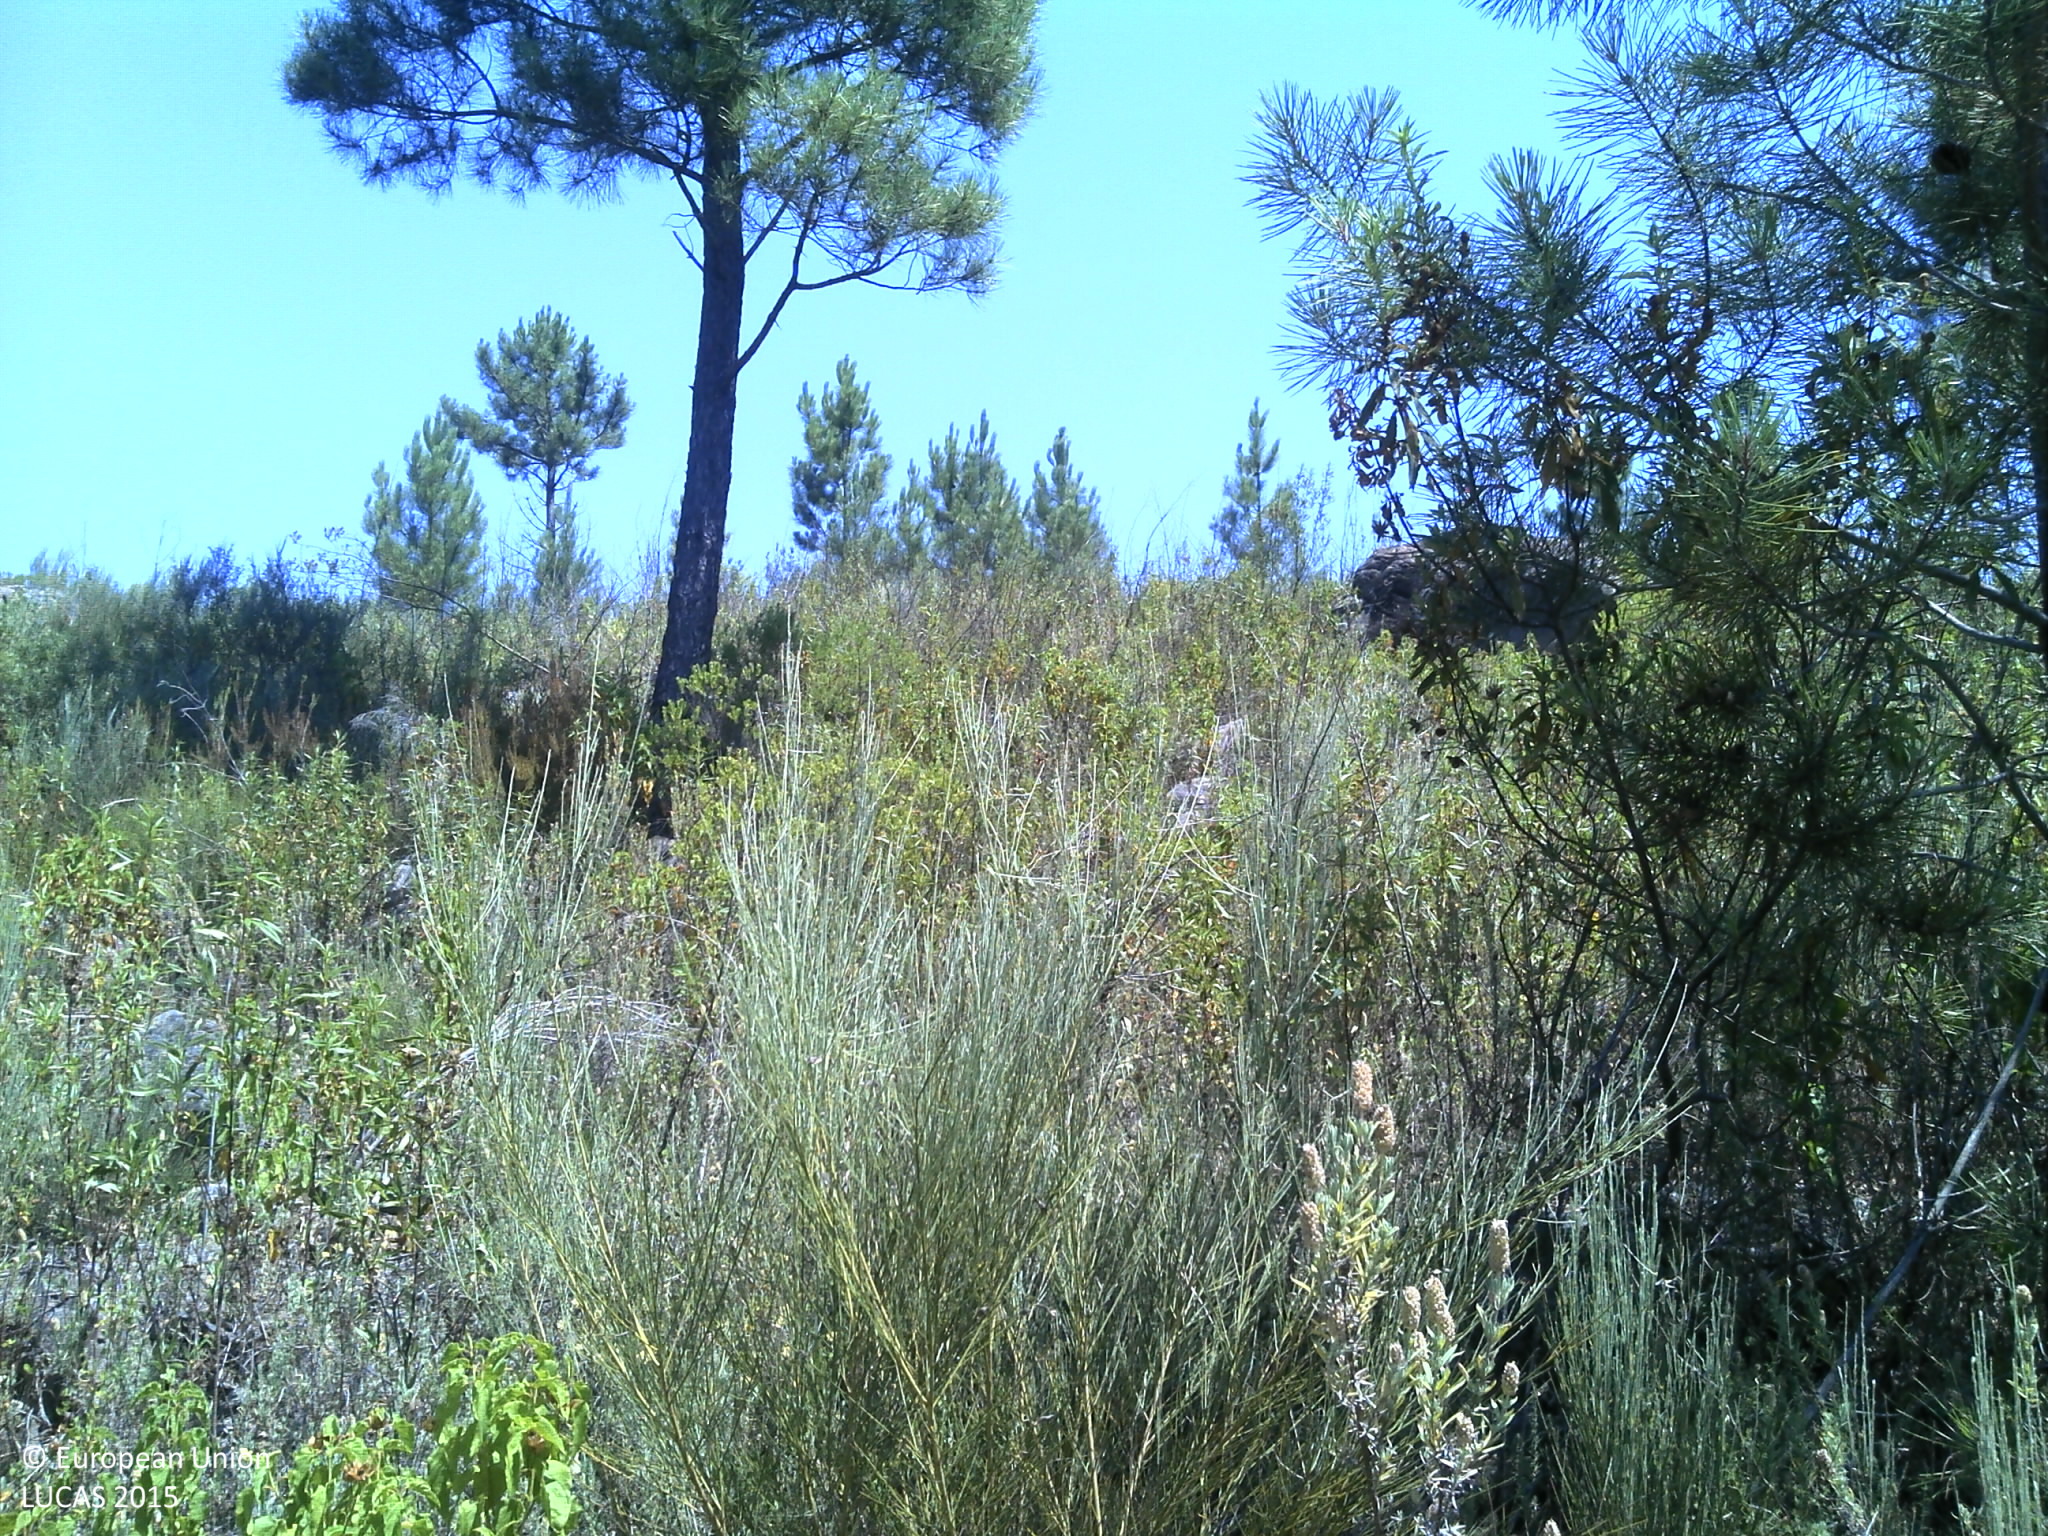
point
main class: Woodland
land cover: Pine dominated coniferous woodland
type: coniferous forest of the mediterranean region
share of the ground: 25 - 50 %
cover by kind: coniferous forest trees 30 %, shrubs 30 %, herbaceous plants 20 %, consolidated bare surface 10 %, unconsolidated bare surface 10 %
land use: Forestry
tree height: > 5 m
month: June
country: PT
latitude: 40.5112
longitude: -7.7857
